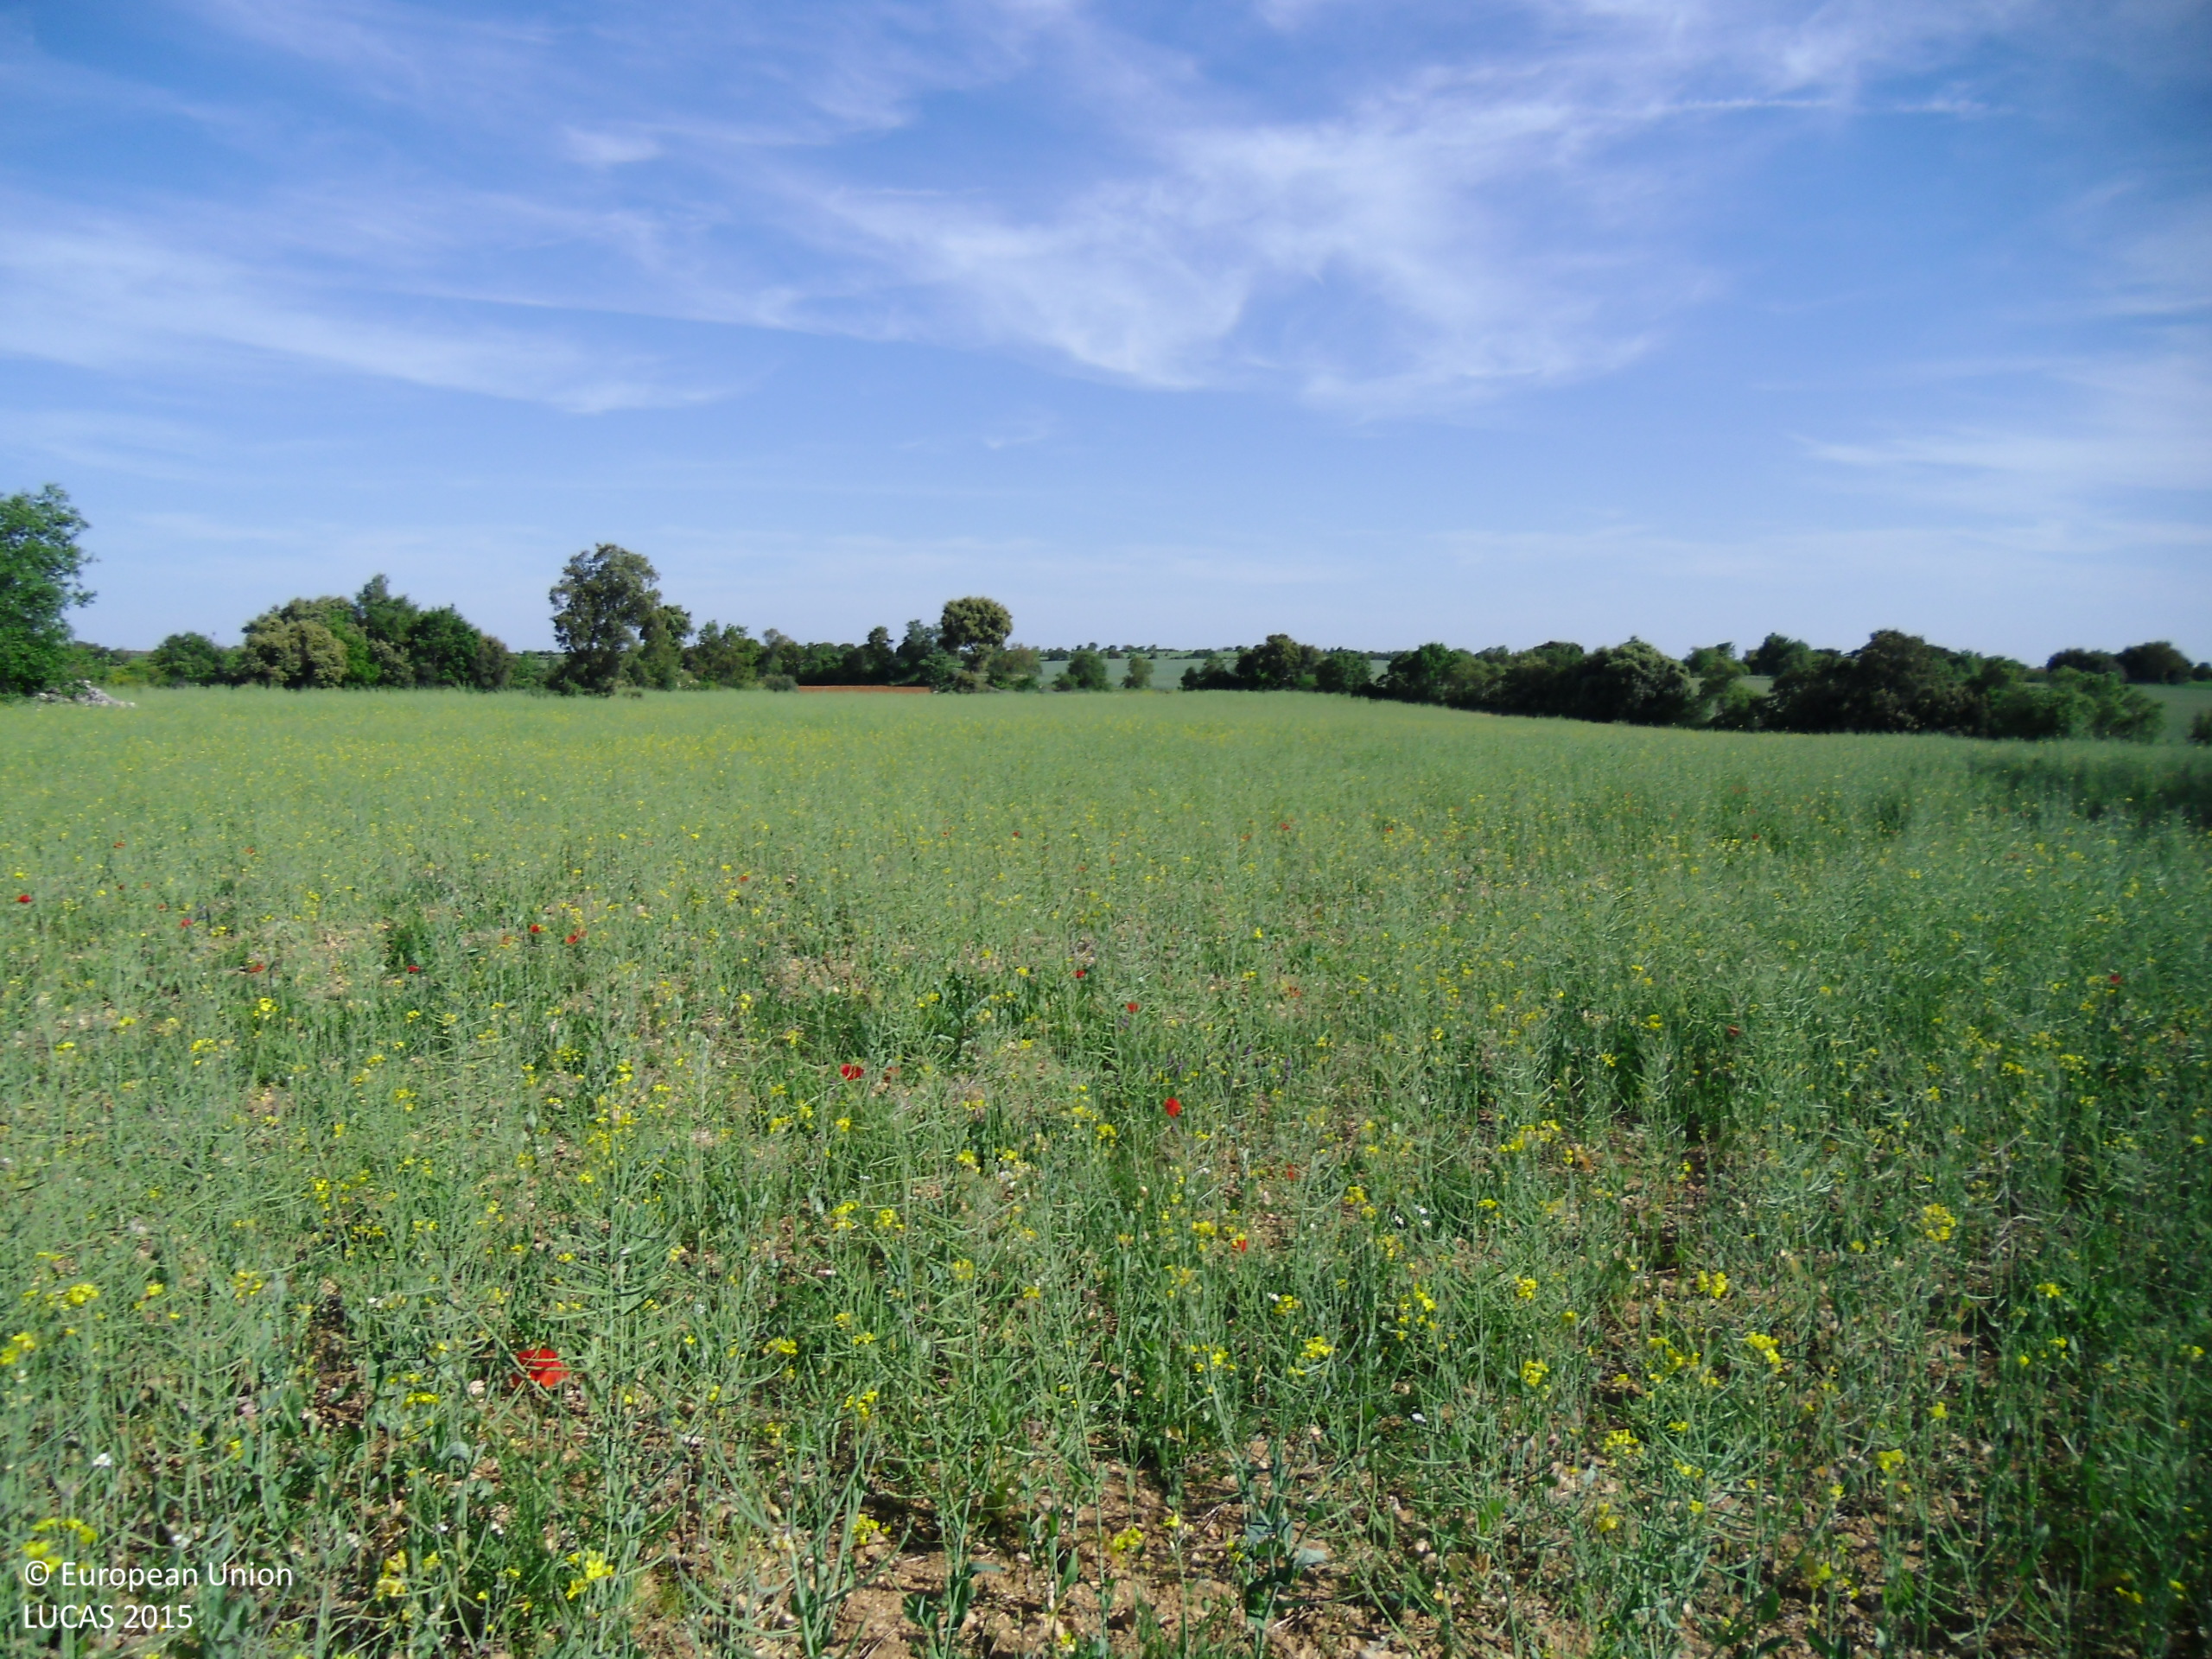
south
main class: Cropland
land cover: Rape and turnip rape
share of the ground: > 75 %
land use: Agriculture (excluding fallow land and kitchen gardens)
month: May
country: ES
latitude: 40.5445
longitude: -2.9114
